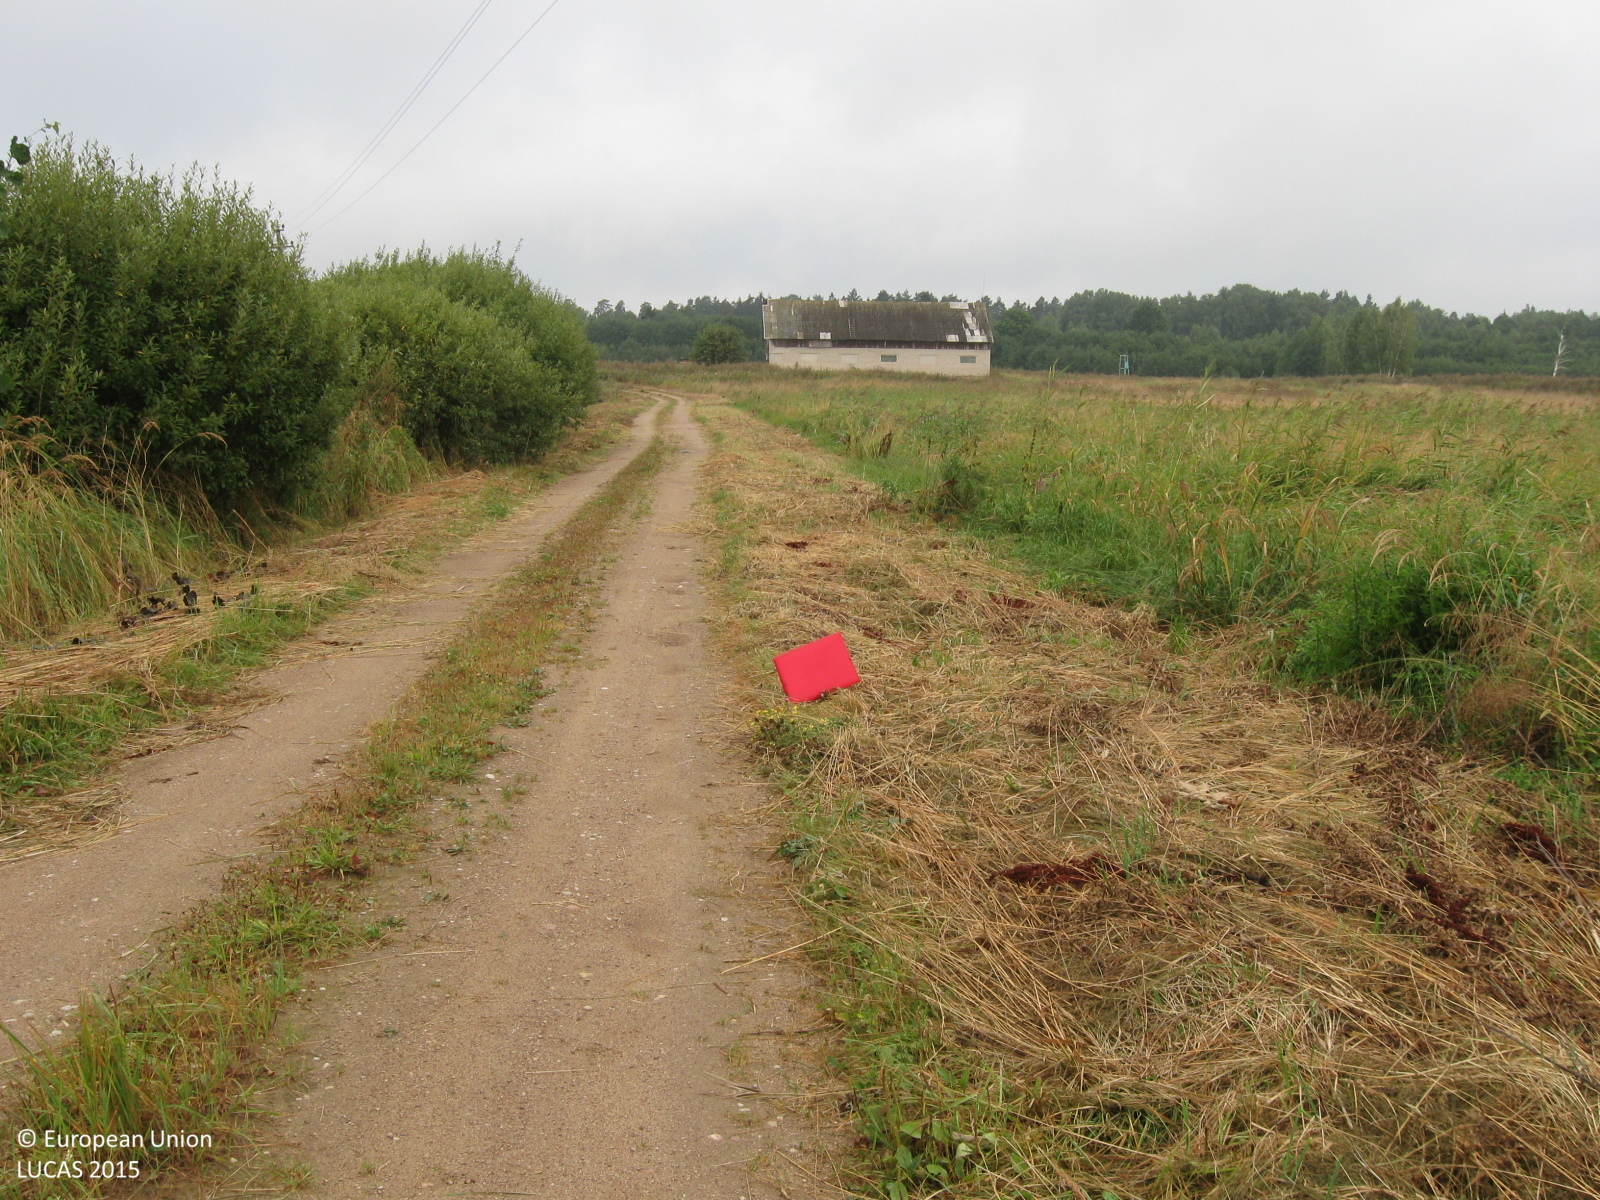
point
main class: Grassland
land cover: Spontaneously vegetated surfaces
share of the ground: > 75 %
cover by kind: herbaceous plants 95 %, consolidated bare surface 5 %
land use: Semi-natural and natural areas not in use
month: August
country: LT
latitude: 55.3453
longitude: 22.9525
